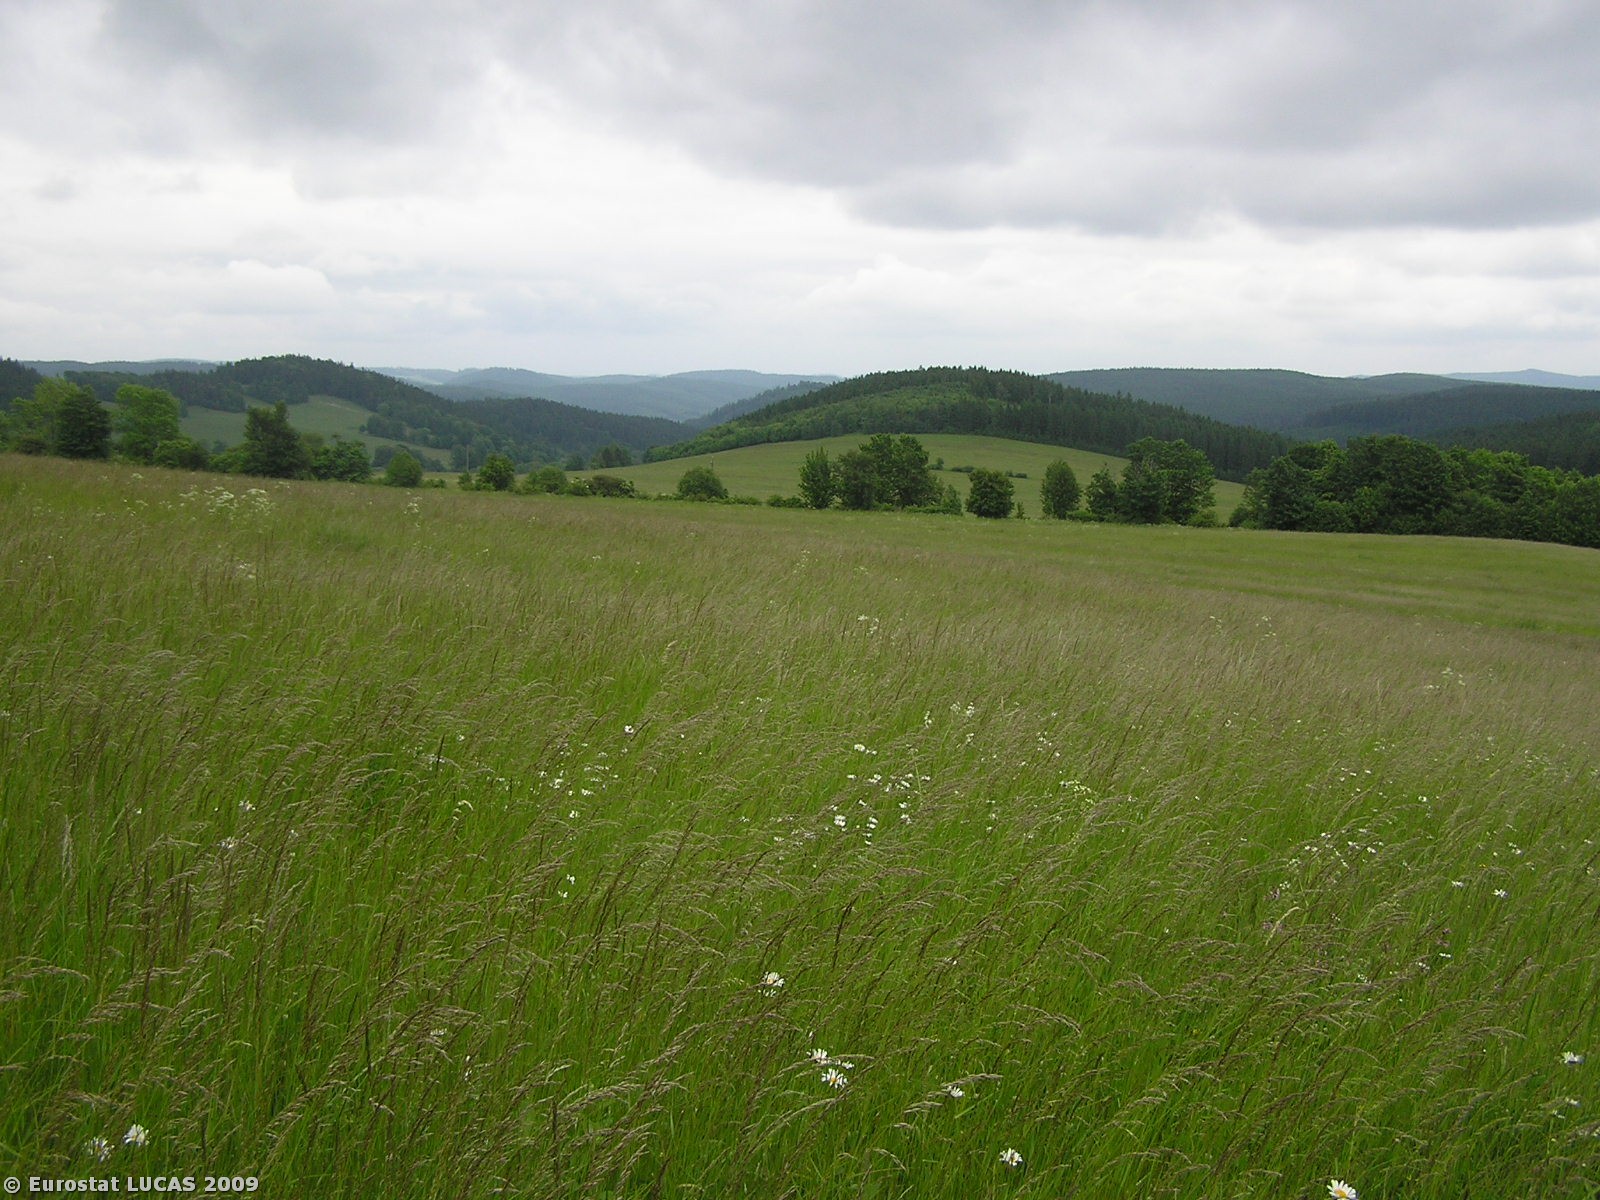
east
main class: Grassland
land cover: Grassland without tree/shrub cover
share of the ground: > 75 %
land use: Agriculture (excluding fallow land and kitchen gardens)
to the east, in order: Grassland without tree/shrub cover; Tracks; Grassland without tree/shrub cover
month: June
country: CZ
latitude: 50.0502
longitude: 17.4278
